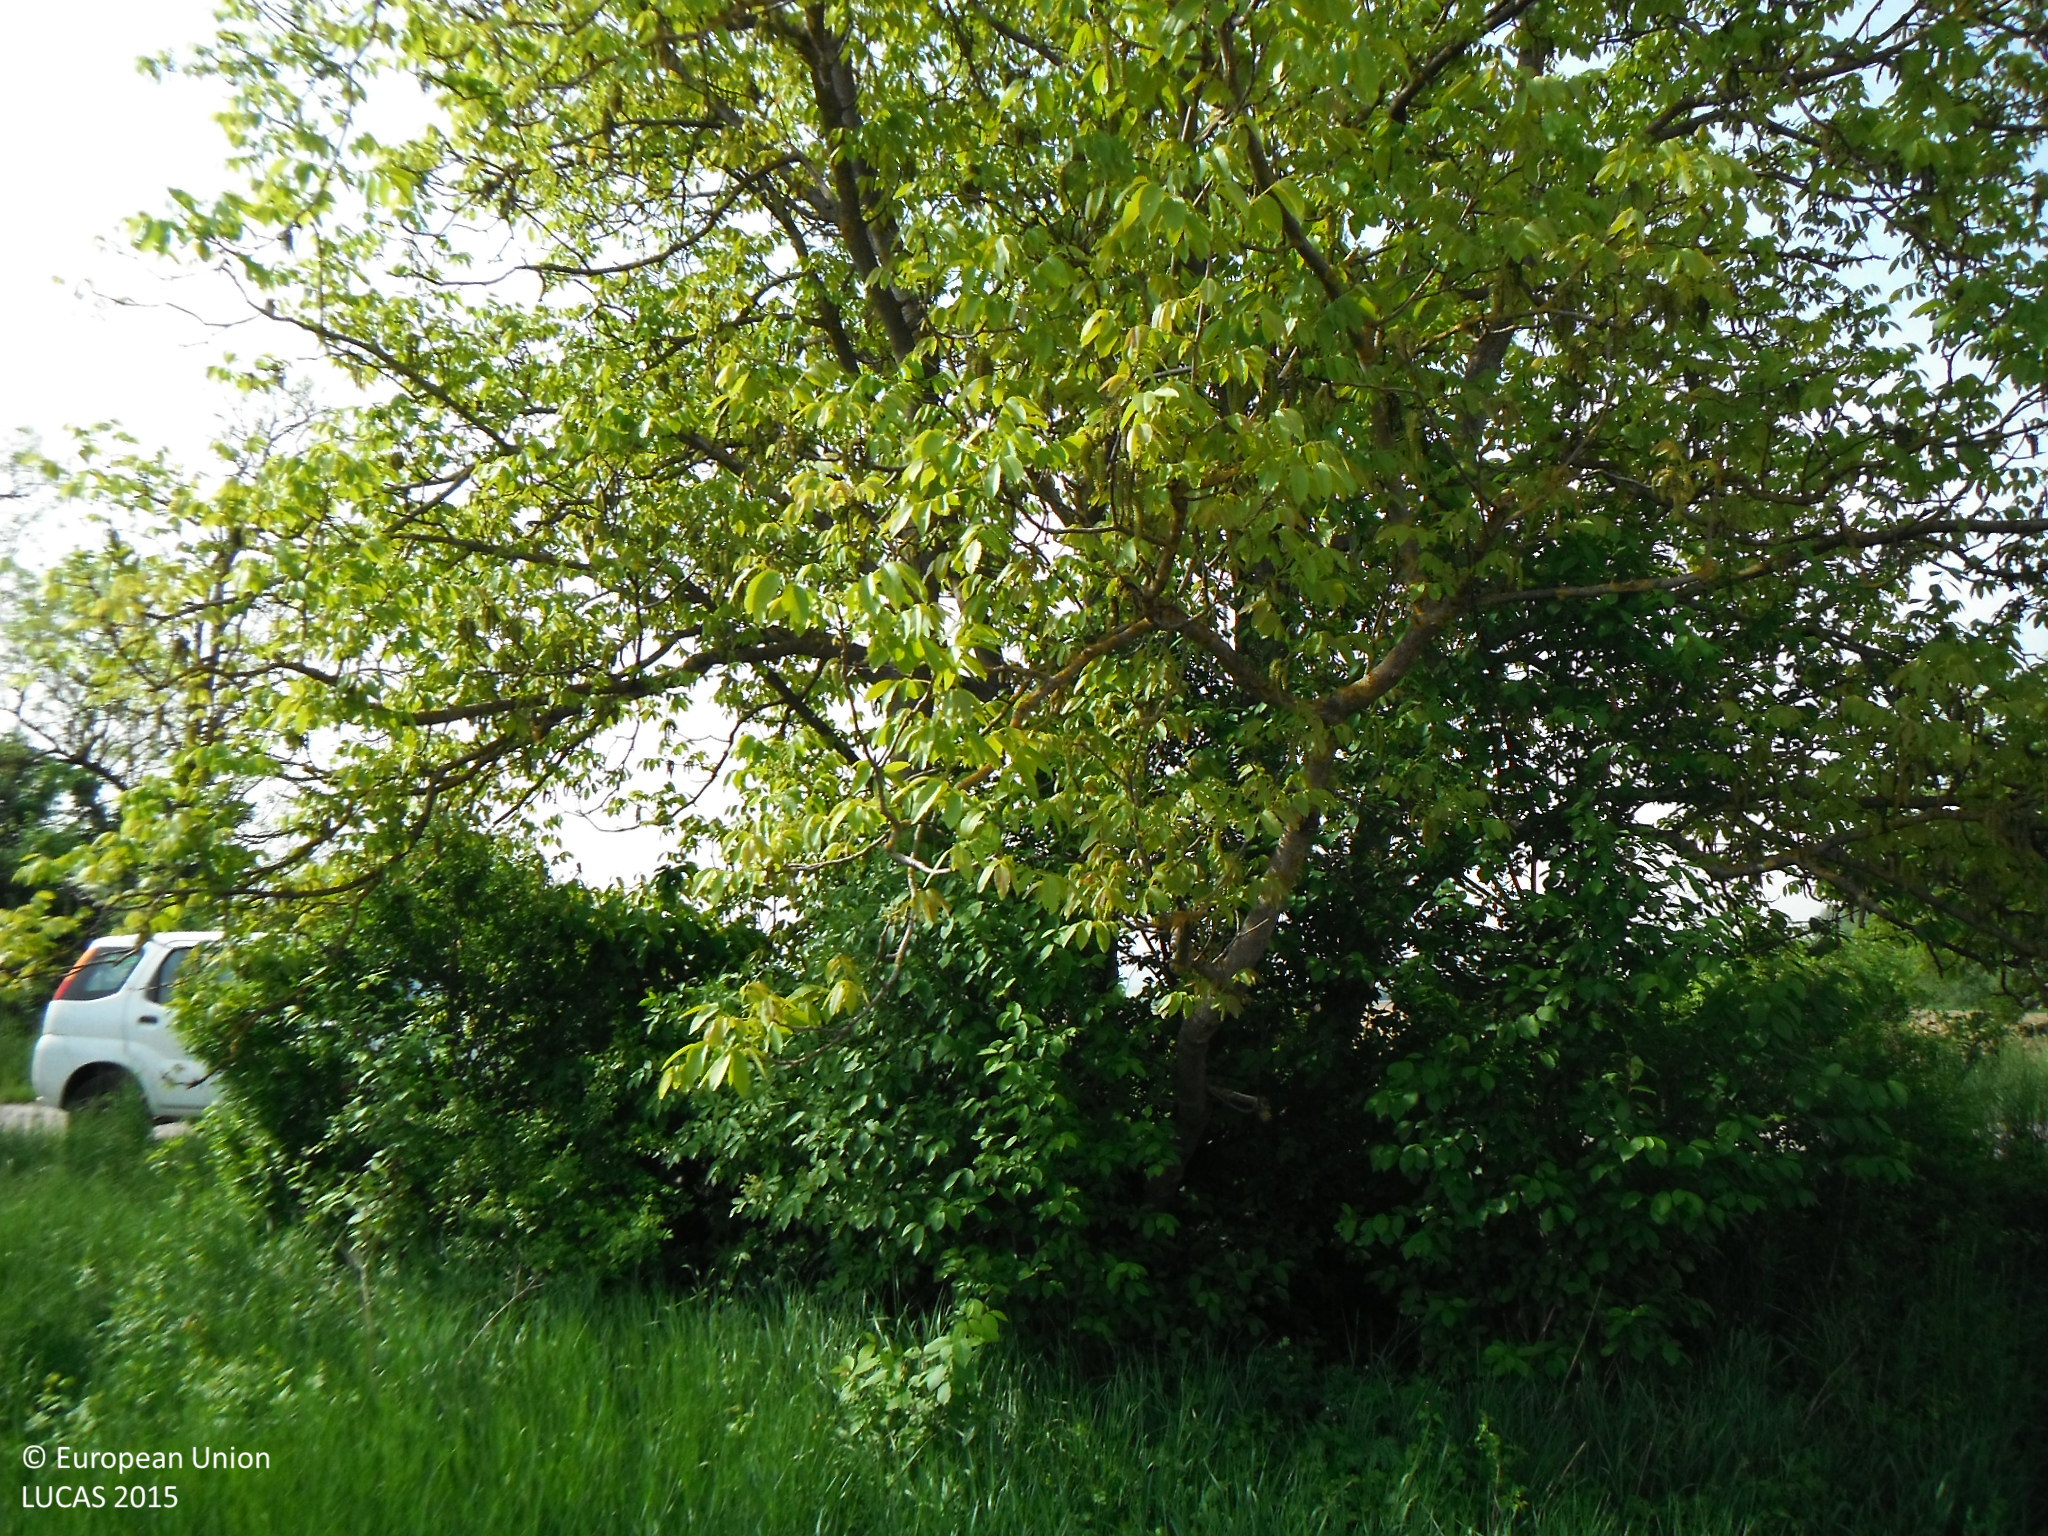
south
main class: Cropland
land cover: Rape and turnip rape
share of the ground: < 10 %
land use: Agriculture (excluding fallow land and kitchen gardens)
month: May
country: SK
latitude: 48.6005
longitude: 21.1489
